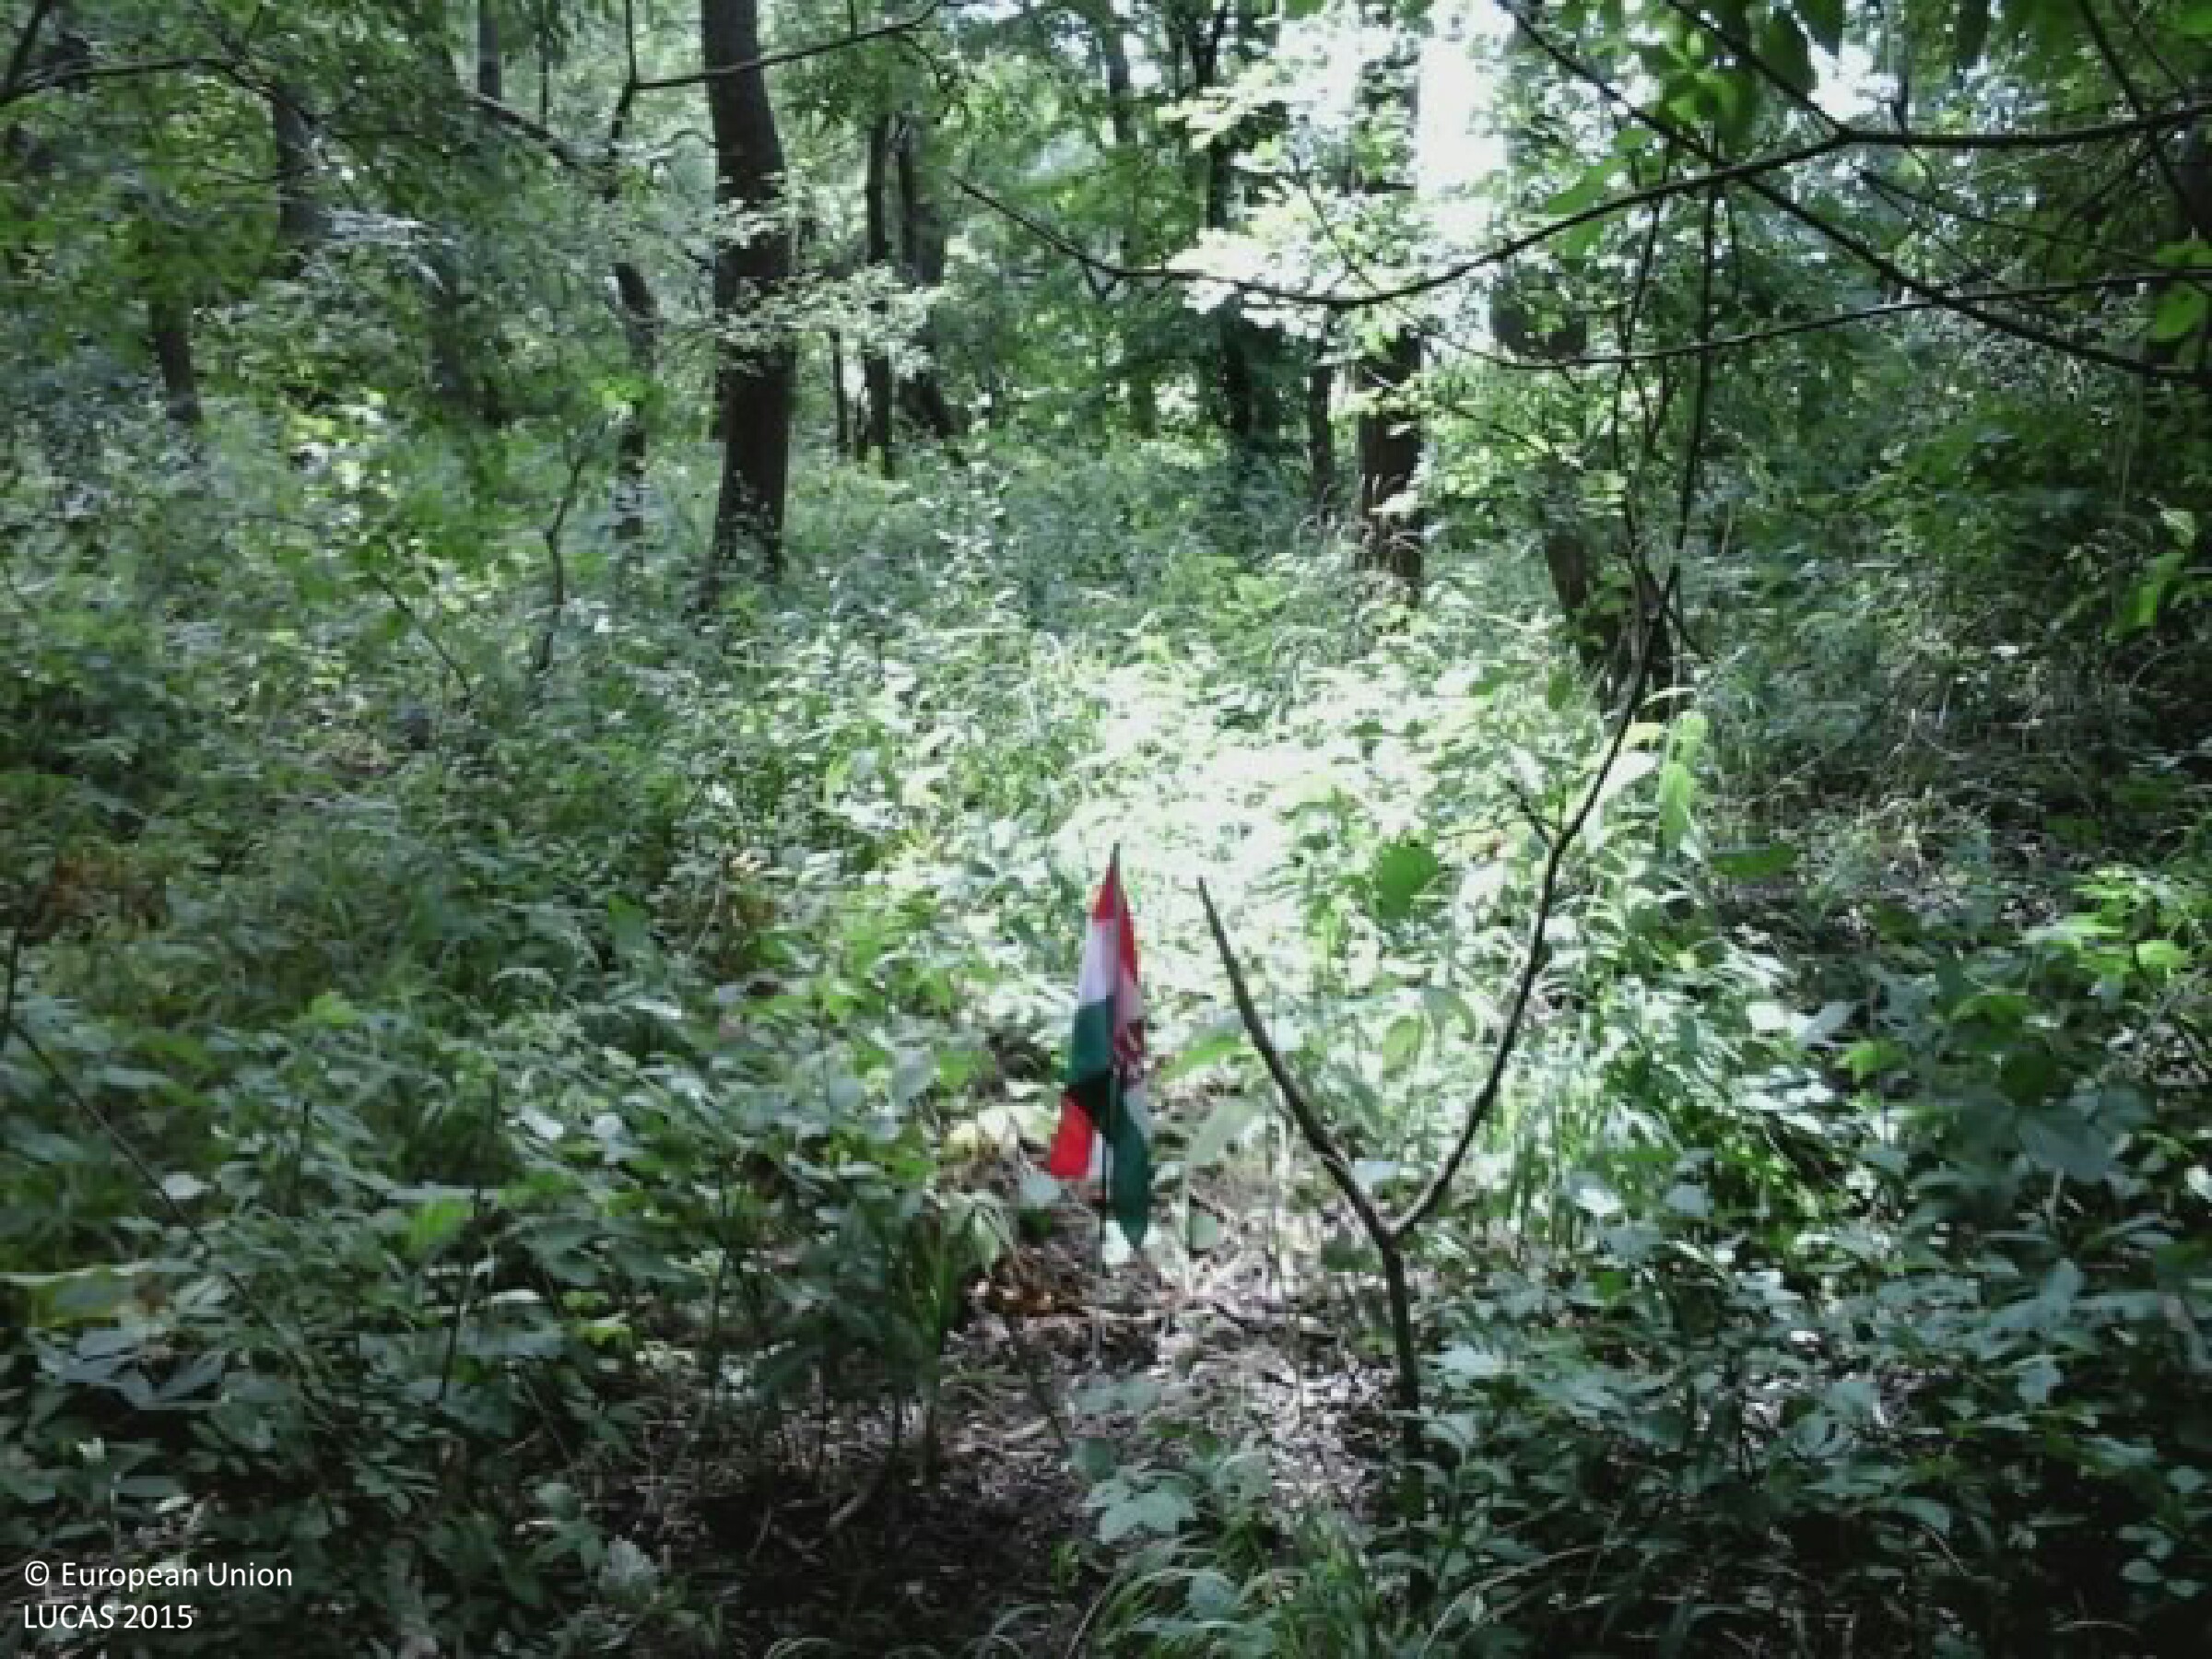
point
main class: Woodland
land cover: Broadleaved woodland
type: thermophilous deciduous forest
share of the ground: > 75 %
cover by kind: broadleaved forest trees 85 %, shrubs 10 %, herbaceous plants 5 %
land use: Forestry
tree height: > 5 m
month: July
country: HU
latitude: 47.2539
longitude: 19.2549
